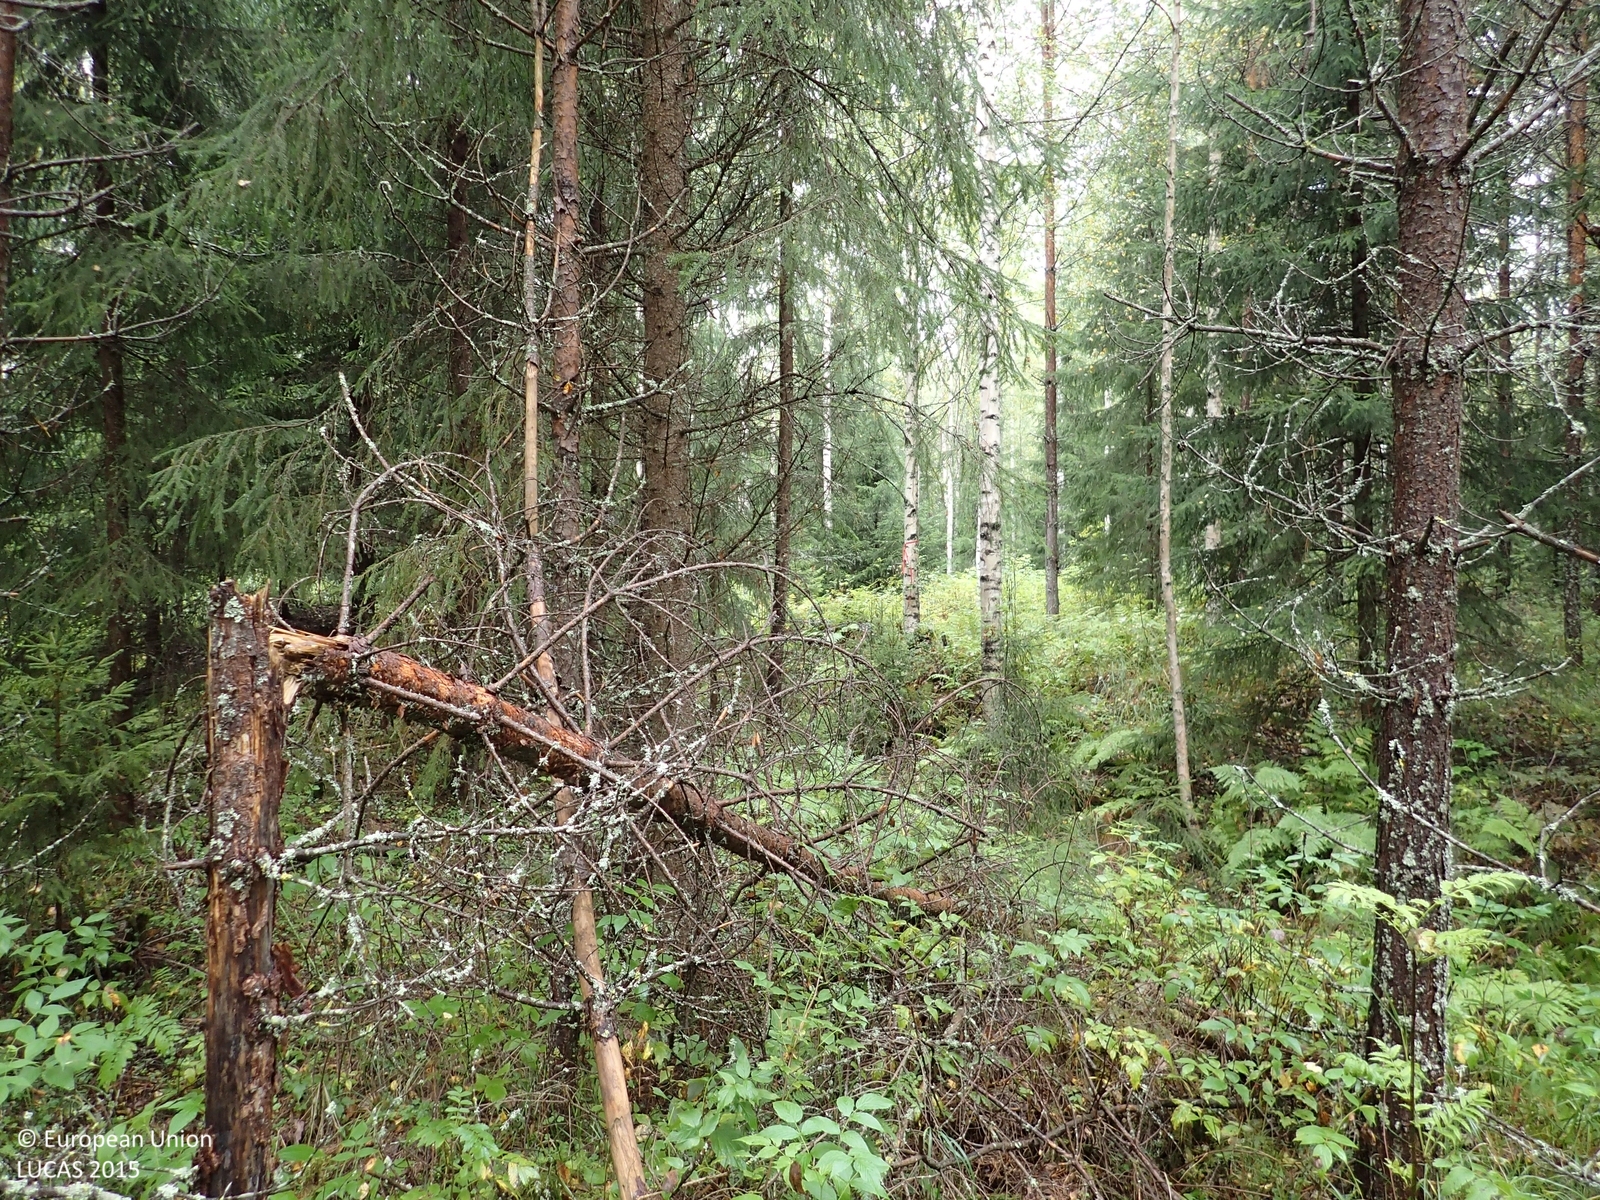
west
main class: Woodland
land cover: Other mixed woodland
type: boreal forest
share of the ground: > 75 %
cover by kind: coniferous forest trees 55 %, broadleaved forest trees 20 %, herbaceous plants 20 %, lichens and mosses 5 %
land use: Forestry
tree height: > 5 m
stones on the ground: < 10 %
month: September
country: FI
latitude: 63.1190
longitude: 25.7936
